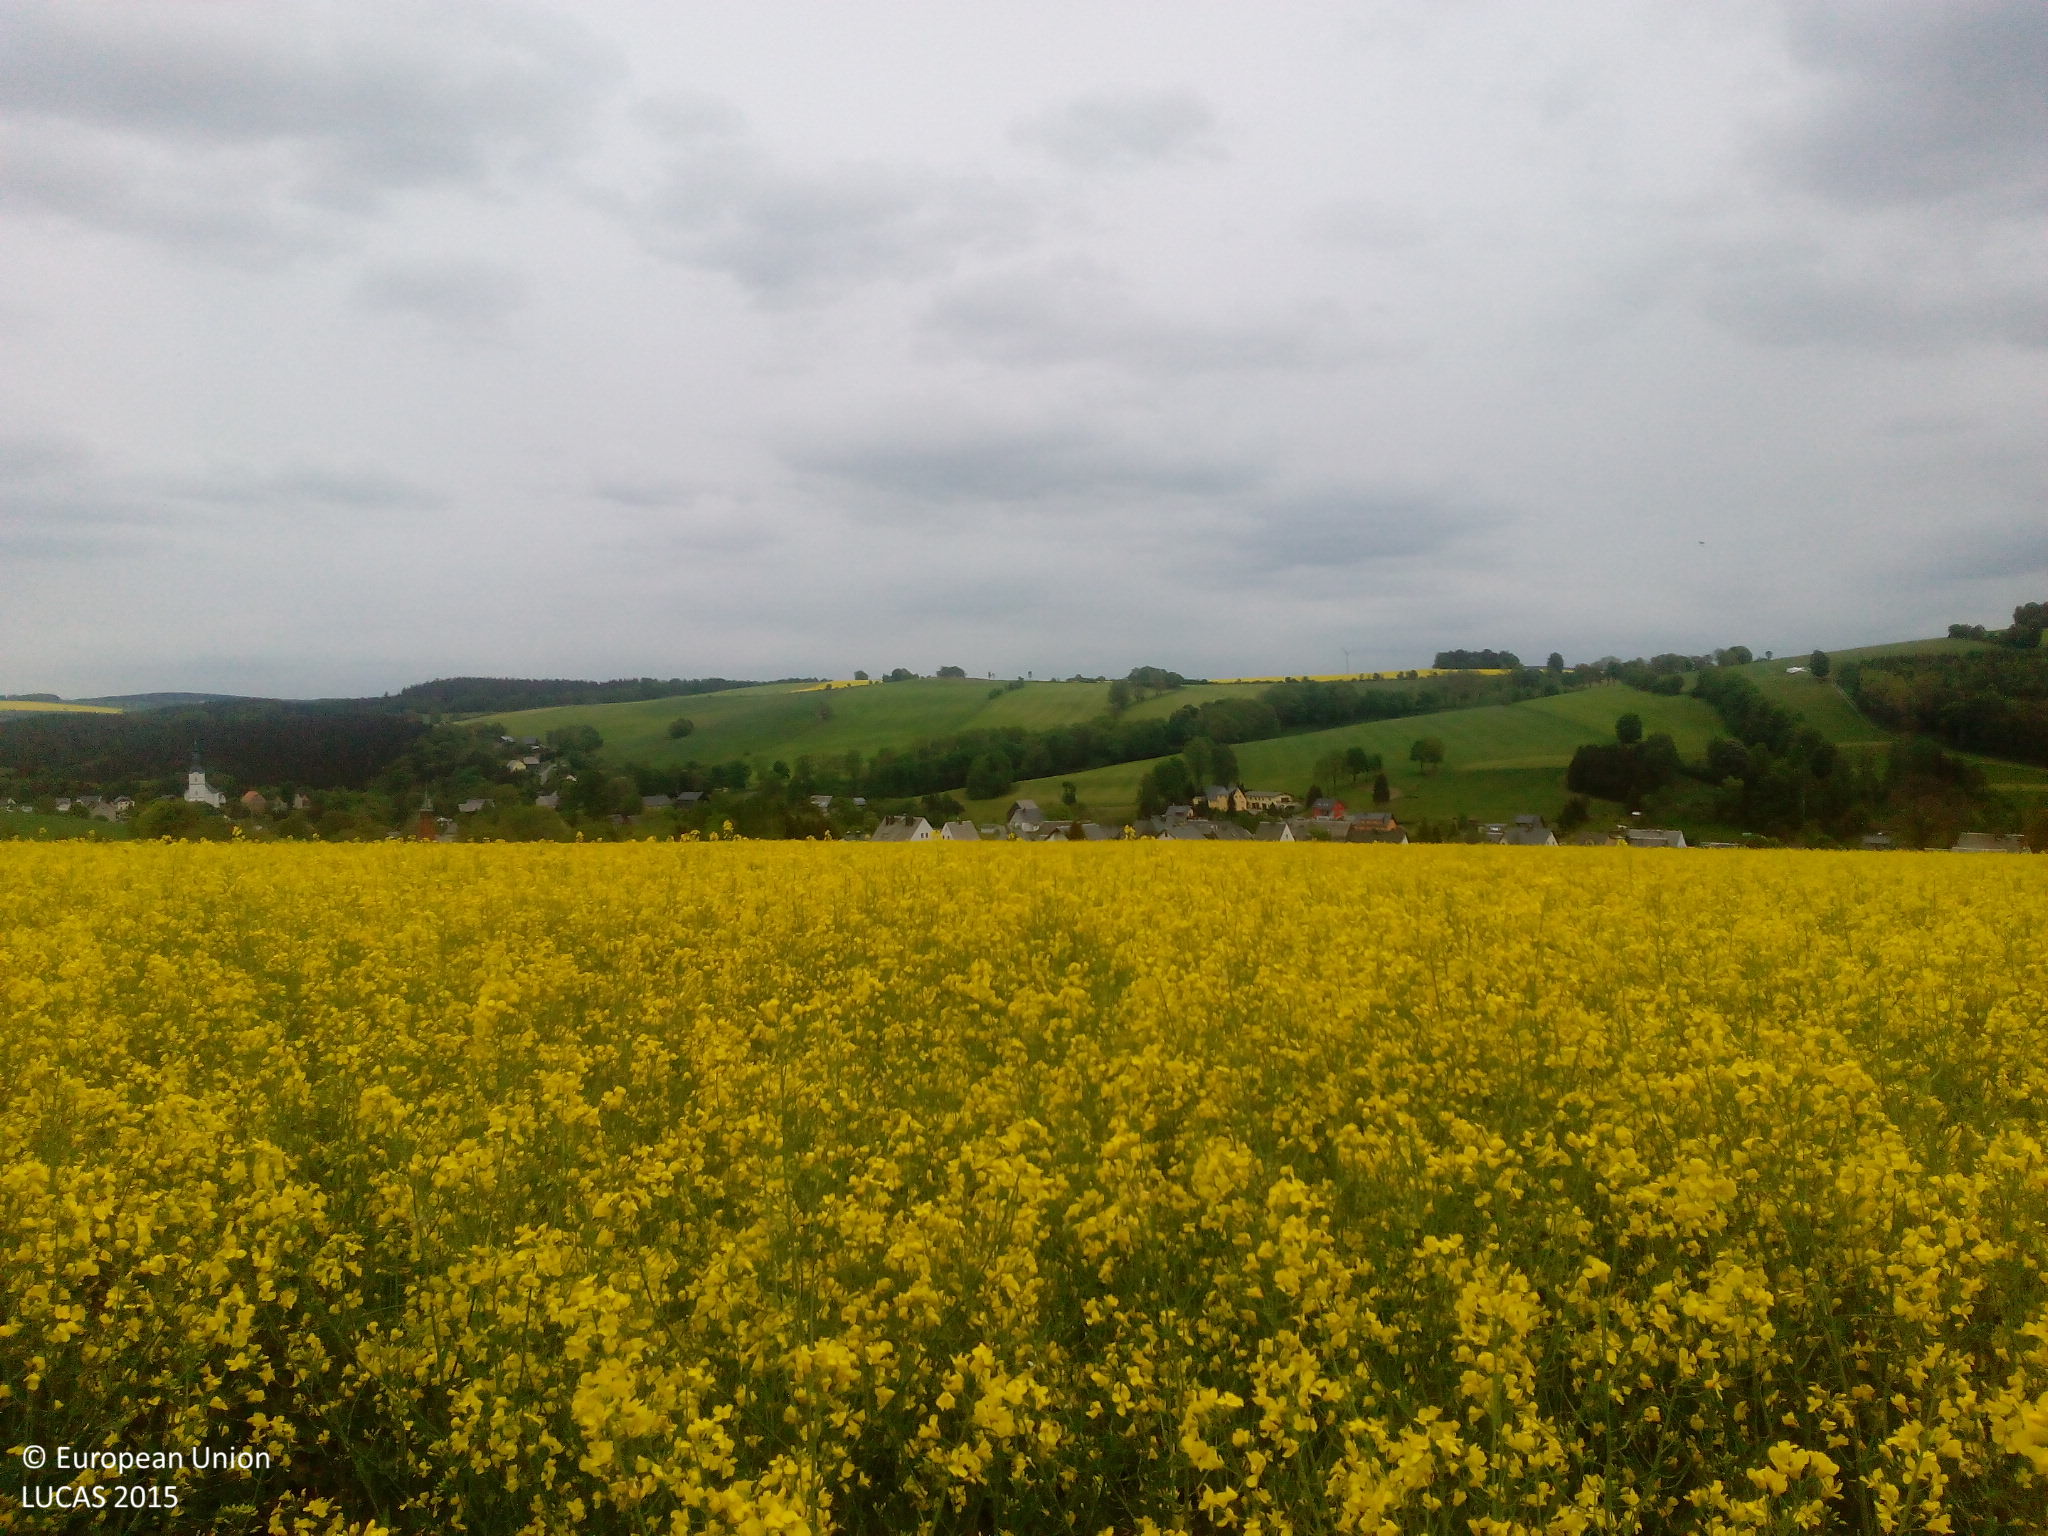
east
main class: Cropland
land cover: Rape and turnip rape
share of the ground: > 75 %
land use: Agriculture (excluding fallow land and kitchen gardens)
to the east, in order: Rape and turnip rape; Tracks; Rape and turnip rape
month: May
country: DE
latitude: 50.6842
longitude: 13.0147
